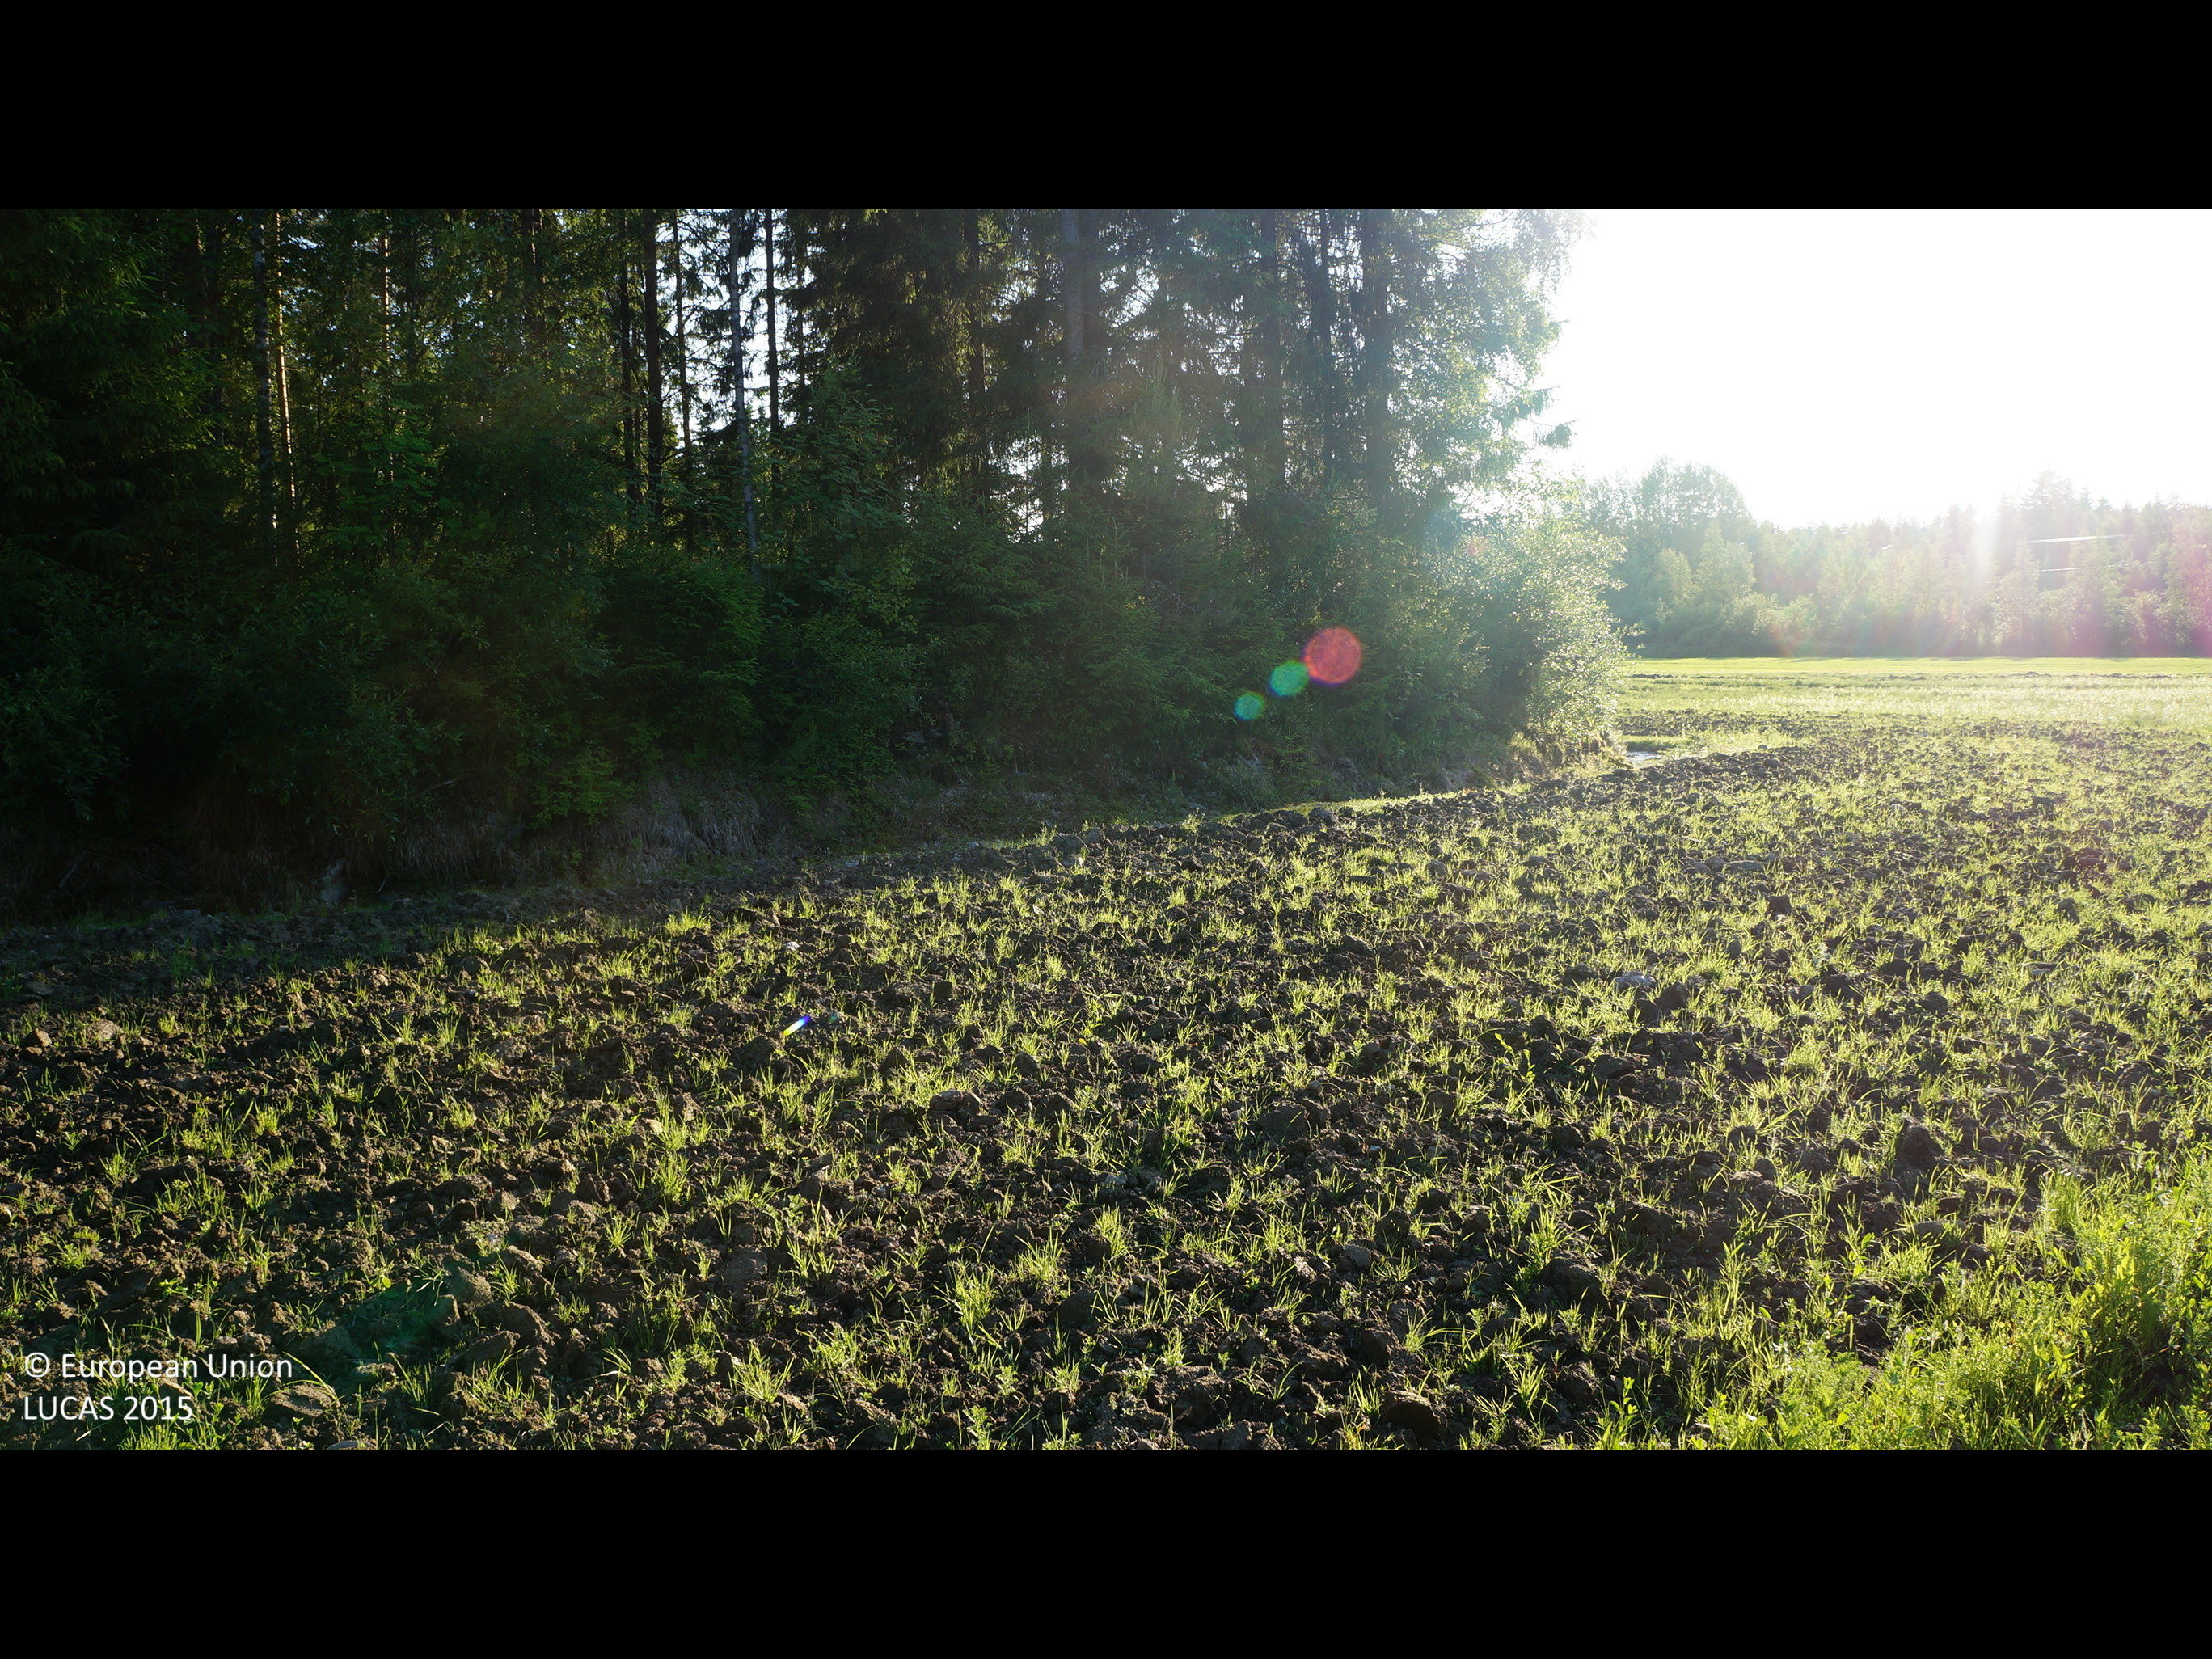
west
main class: Grassland
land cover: Grassland without tree/shrub cover
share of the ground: > 75 %
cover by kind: herbaceous plants 95 %, unconsolidated bare surface 5 %
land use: Agriculture (excluding fallow land and kitchen gardens)
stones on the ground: < 10 %
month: July
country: FI
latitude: 63.6832
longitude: 22.9299
